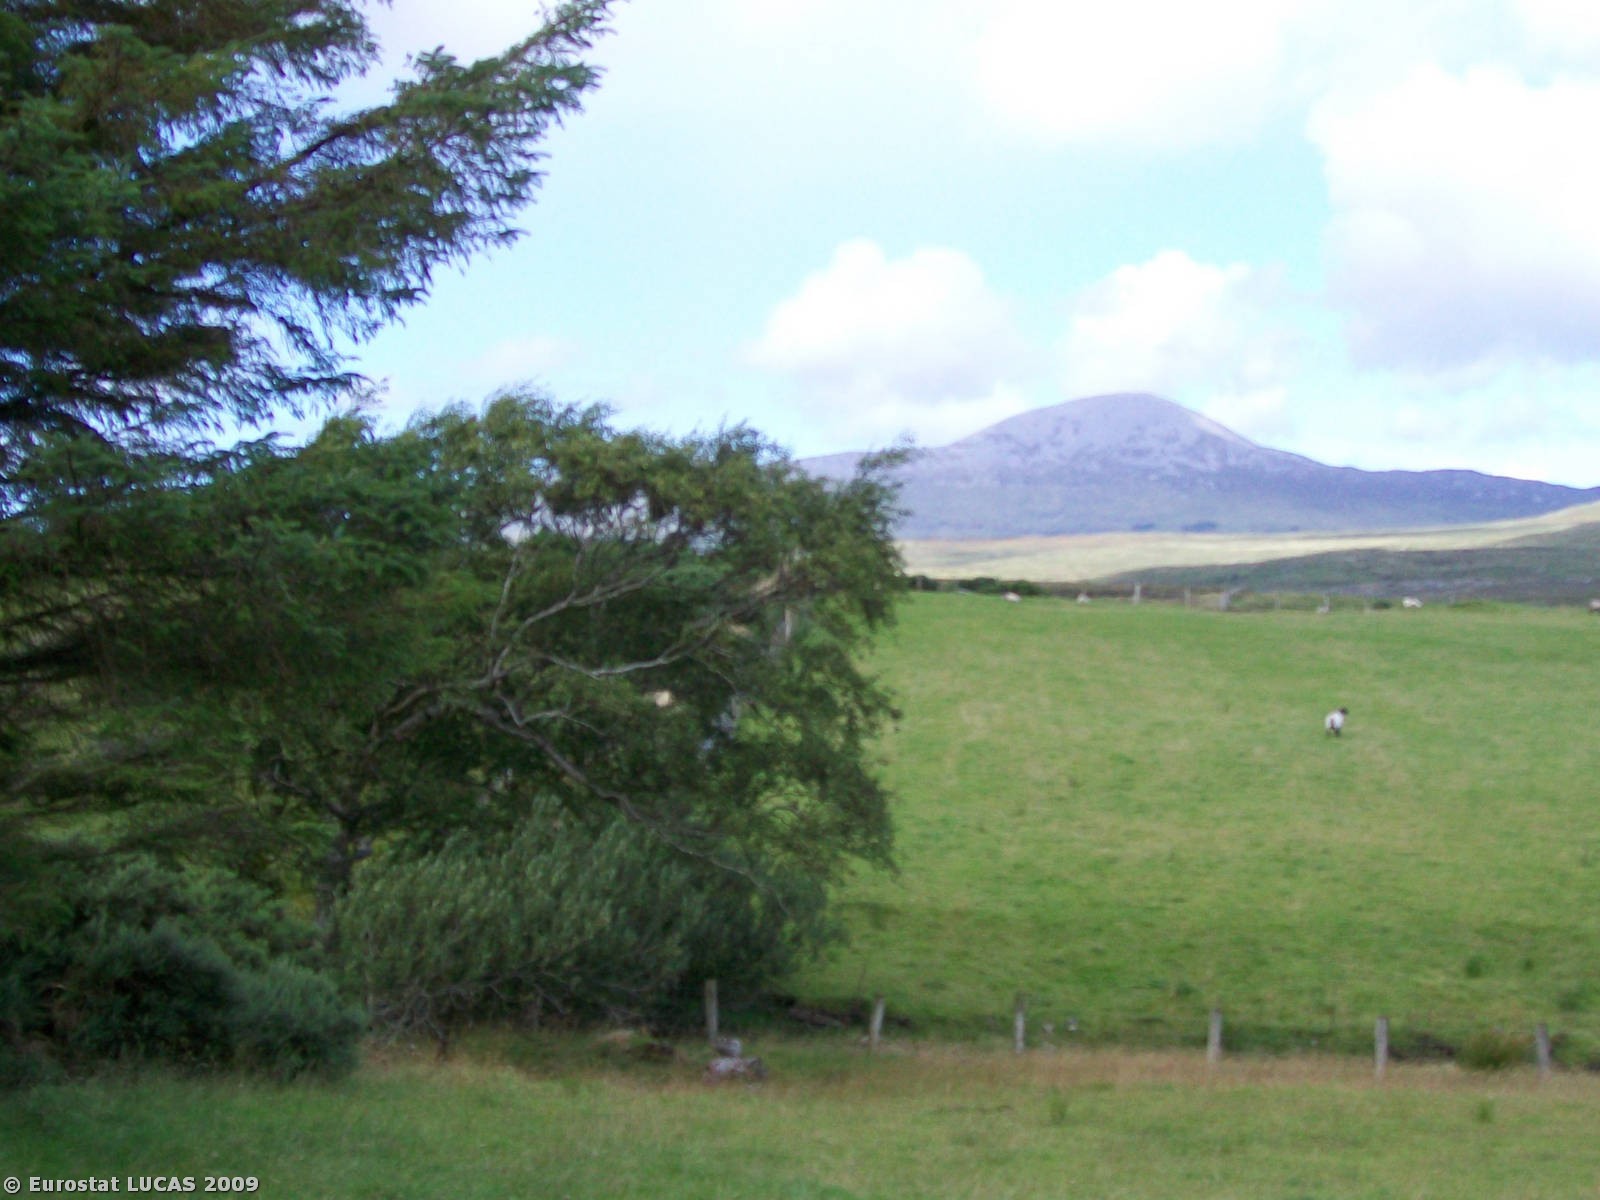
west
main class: Grassland
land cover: Grassland without tree/shrub cover
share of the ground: > 75 %
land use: Agriculture (excluding fallow land and kitchen gardens)
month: July
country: IE
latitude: 53.6982
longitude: -9.6405
